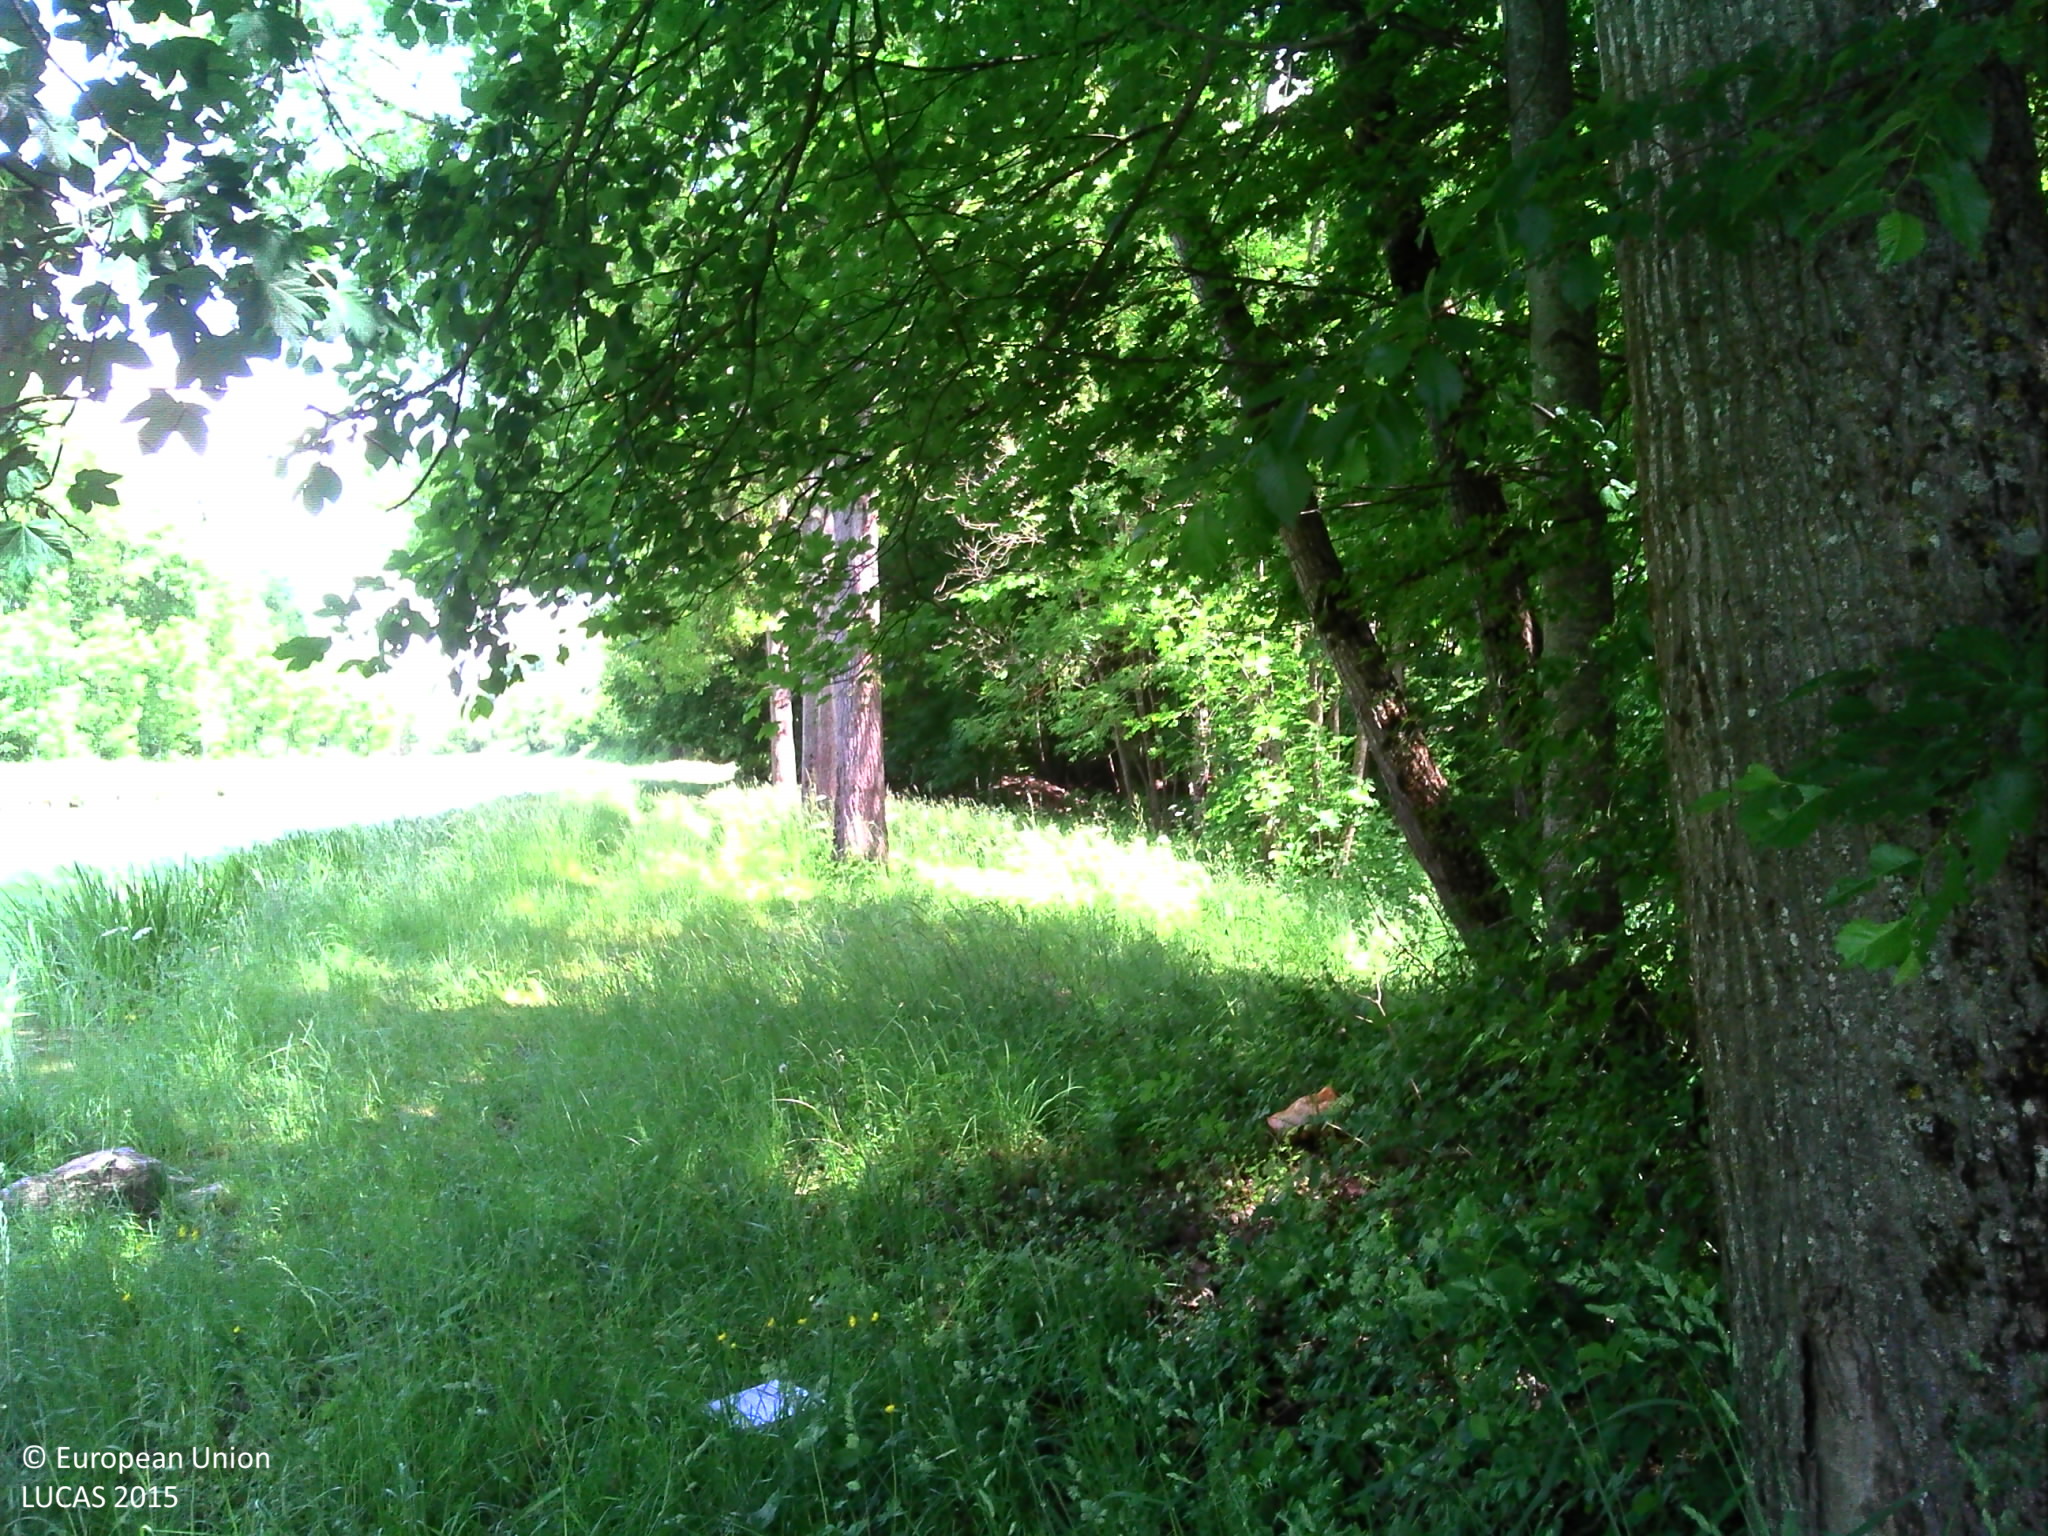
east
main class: Woodland
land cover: Broadleaved woodland
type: mesophytic deciduous forest
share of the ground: > 75 %
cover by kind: broadleaved forest trees 80 %, shrubs 20 %
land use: Semi-natural and natural areas not in use
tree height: > 5 m
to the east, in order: Broadleaved woodland; Tracks; Broadleaved woodland; Grass margins; Paved roads, cycling and walking lanes; Grass margins; Grassland with sparse tree/shrub cover; Ditches and canals; Managed hedges; Grass margins; Paved roads, cycling and walking lanes; Grassland without tree/shrub cover; Pine dominated mixed woodland
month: May
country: FR
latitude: 47.3112
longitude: 4.8810
